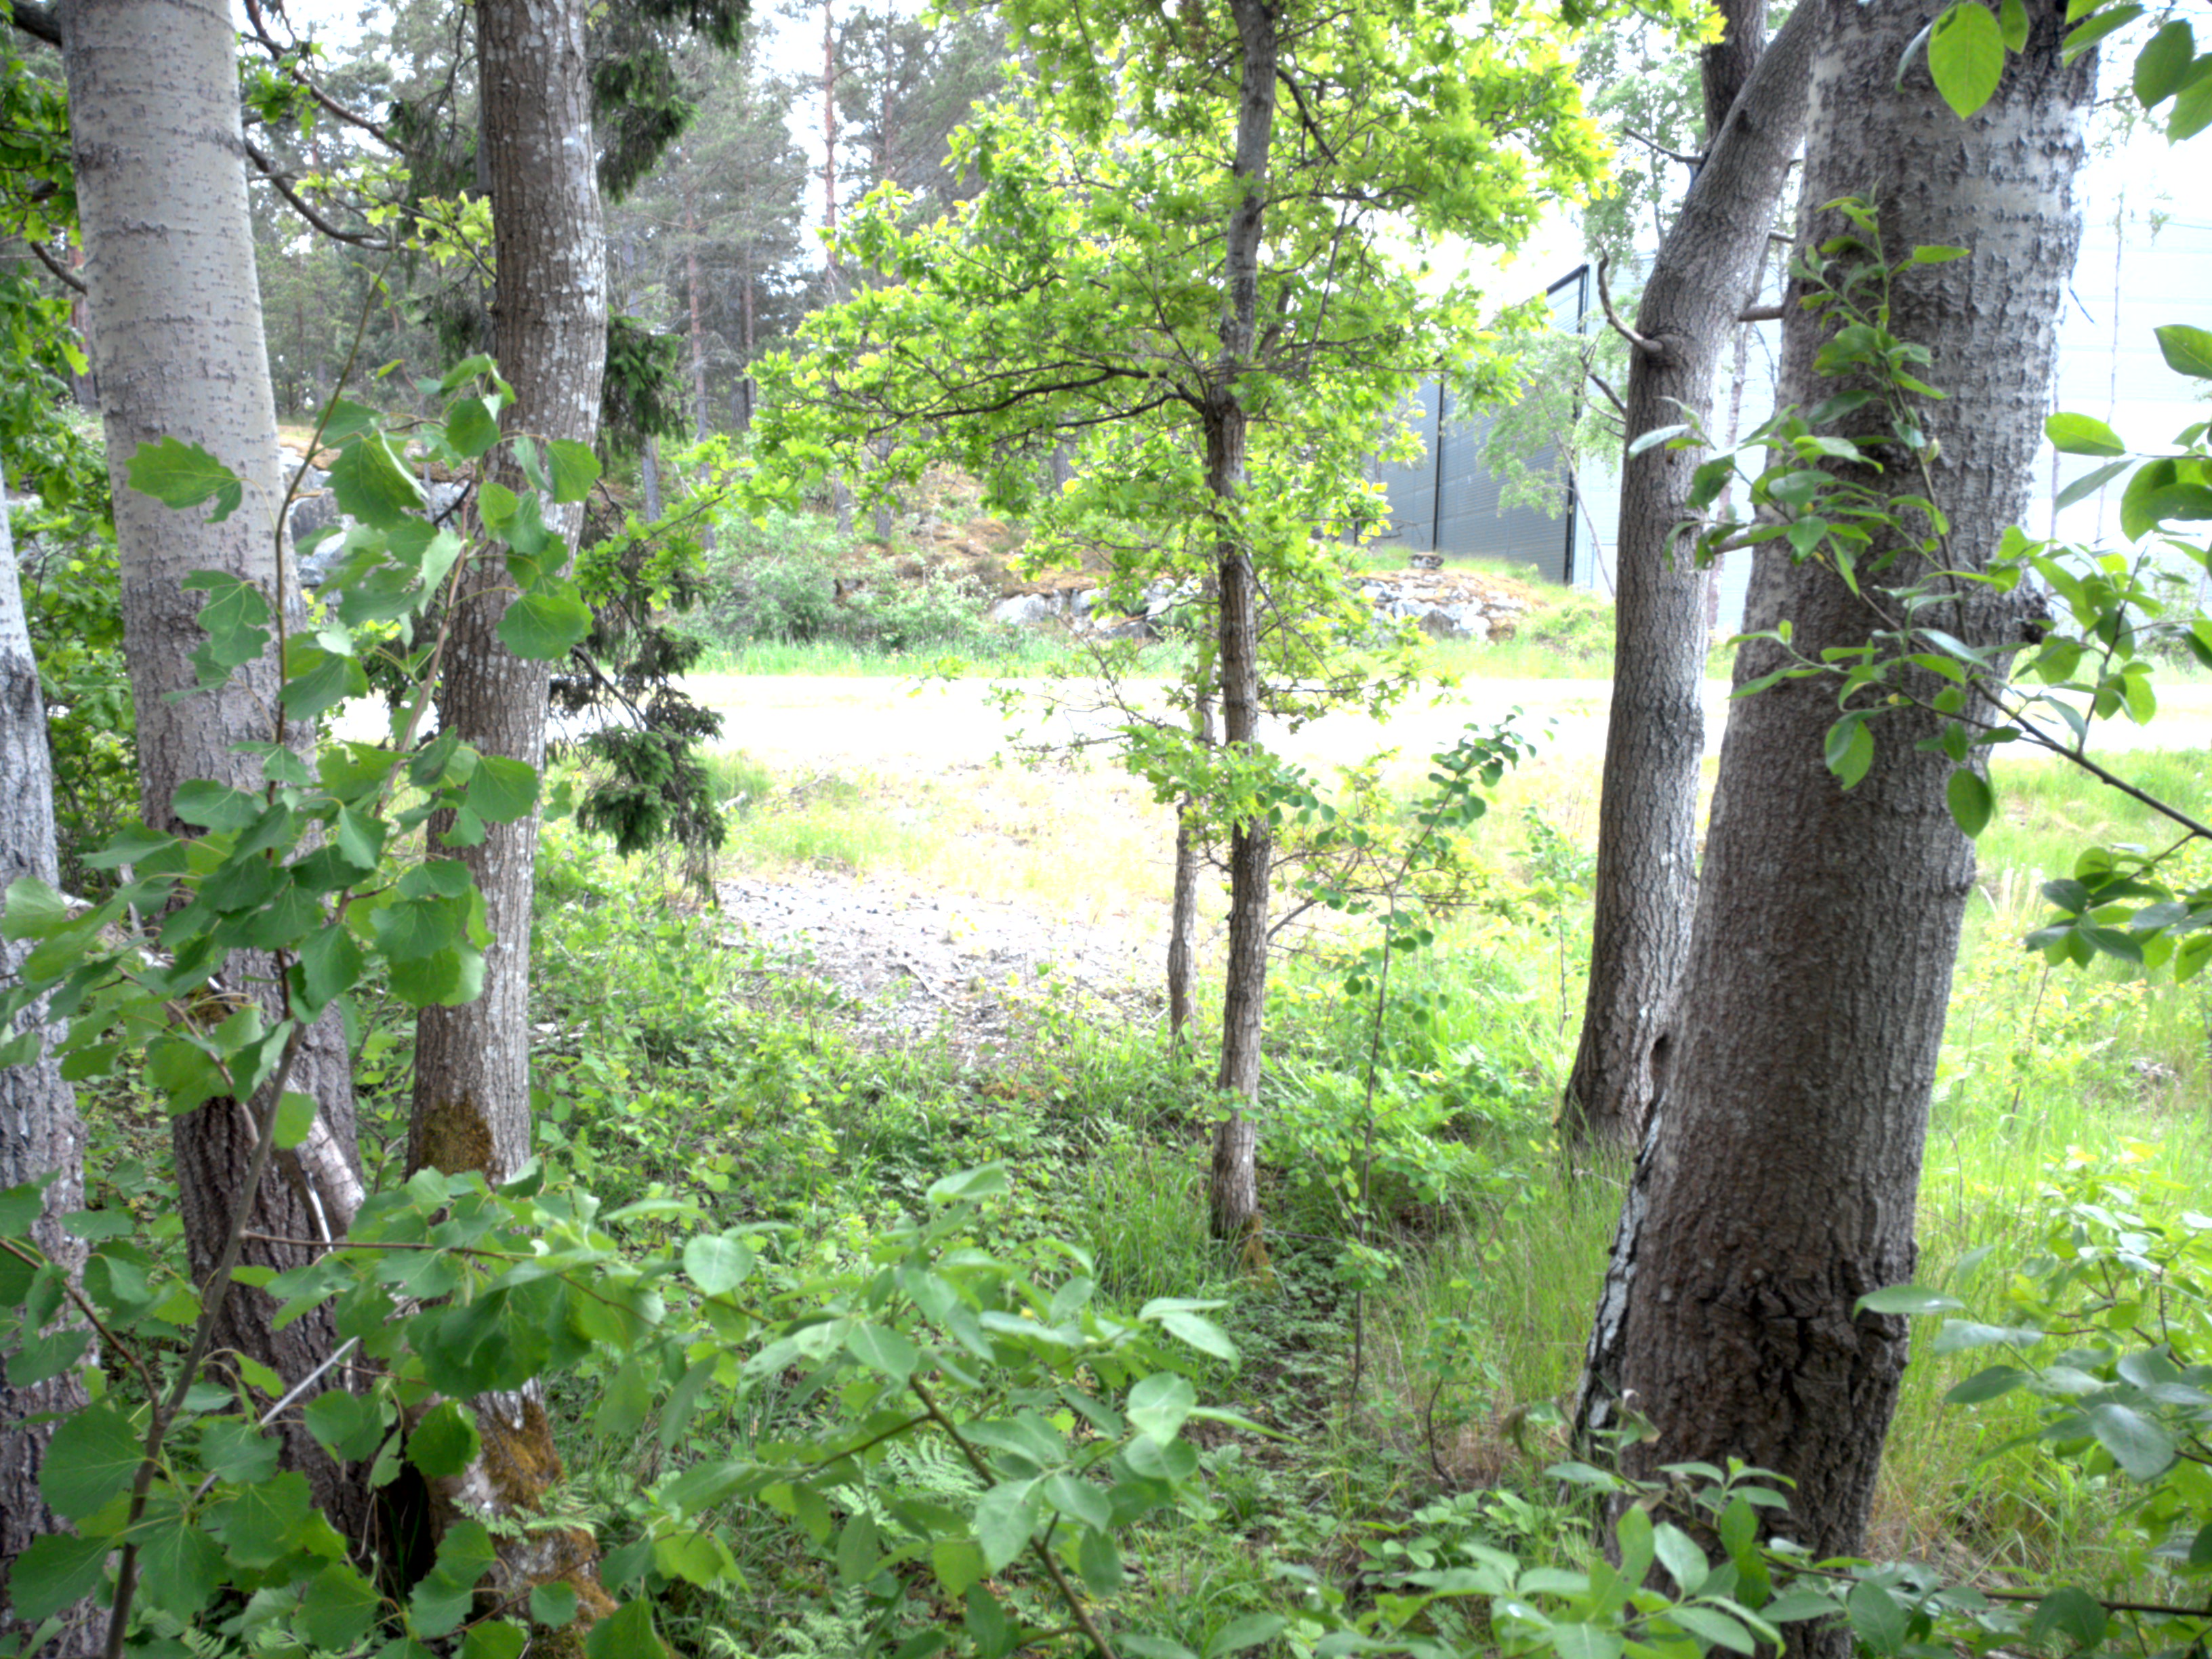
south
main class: Woodland
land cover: Broadleaved woodland
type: non-riverine alder, birch or aspen forest
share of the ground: > 75 %
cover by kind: broadleaved forest trees 60 %, coniferous forest trees 20 %, shrubs 10 %, herbaceous plants 10 %
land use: Forestry
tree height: > 5 m
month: June
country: SE
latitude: 59.3059
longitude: 18.2369
